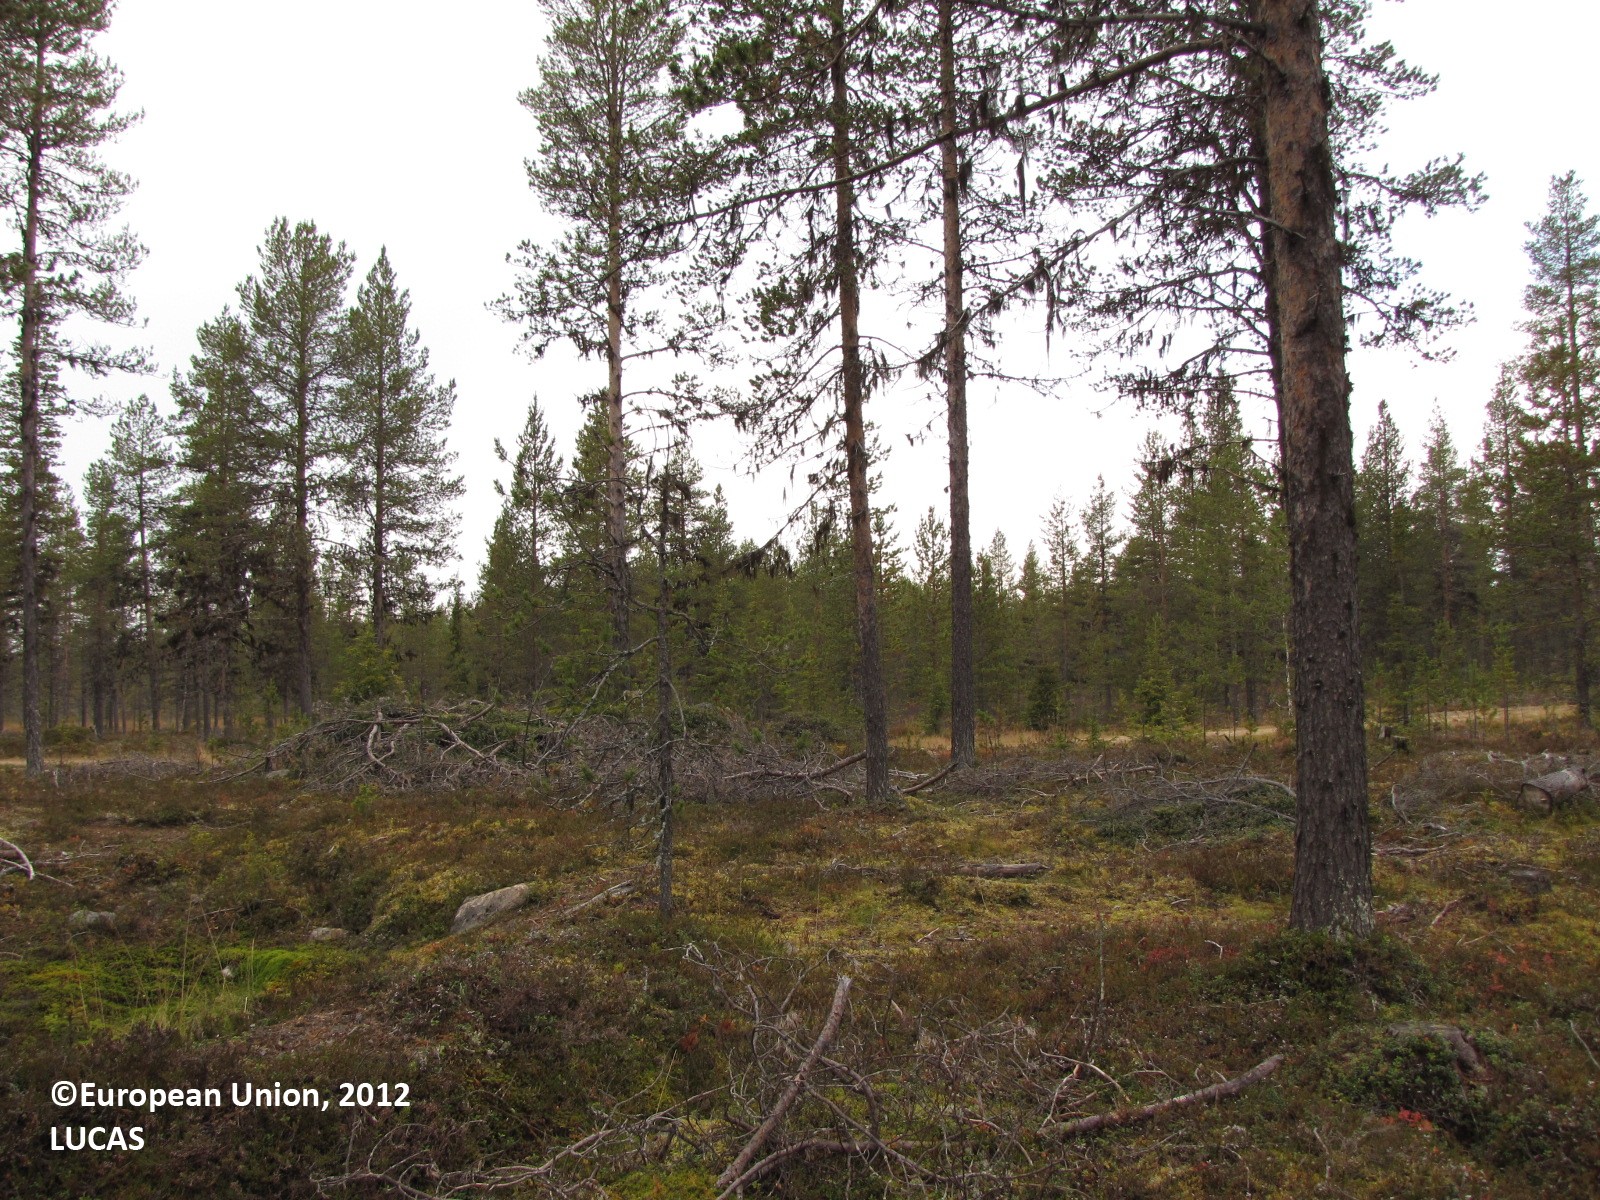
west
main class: Woodland
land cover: Pine dominated coniferous woodland
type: boreal forest
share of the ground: 25 - 50 %
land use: Forestry
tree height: > 5 m
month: September
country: FI
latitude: 67.7104
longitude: 24.1264
